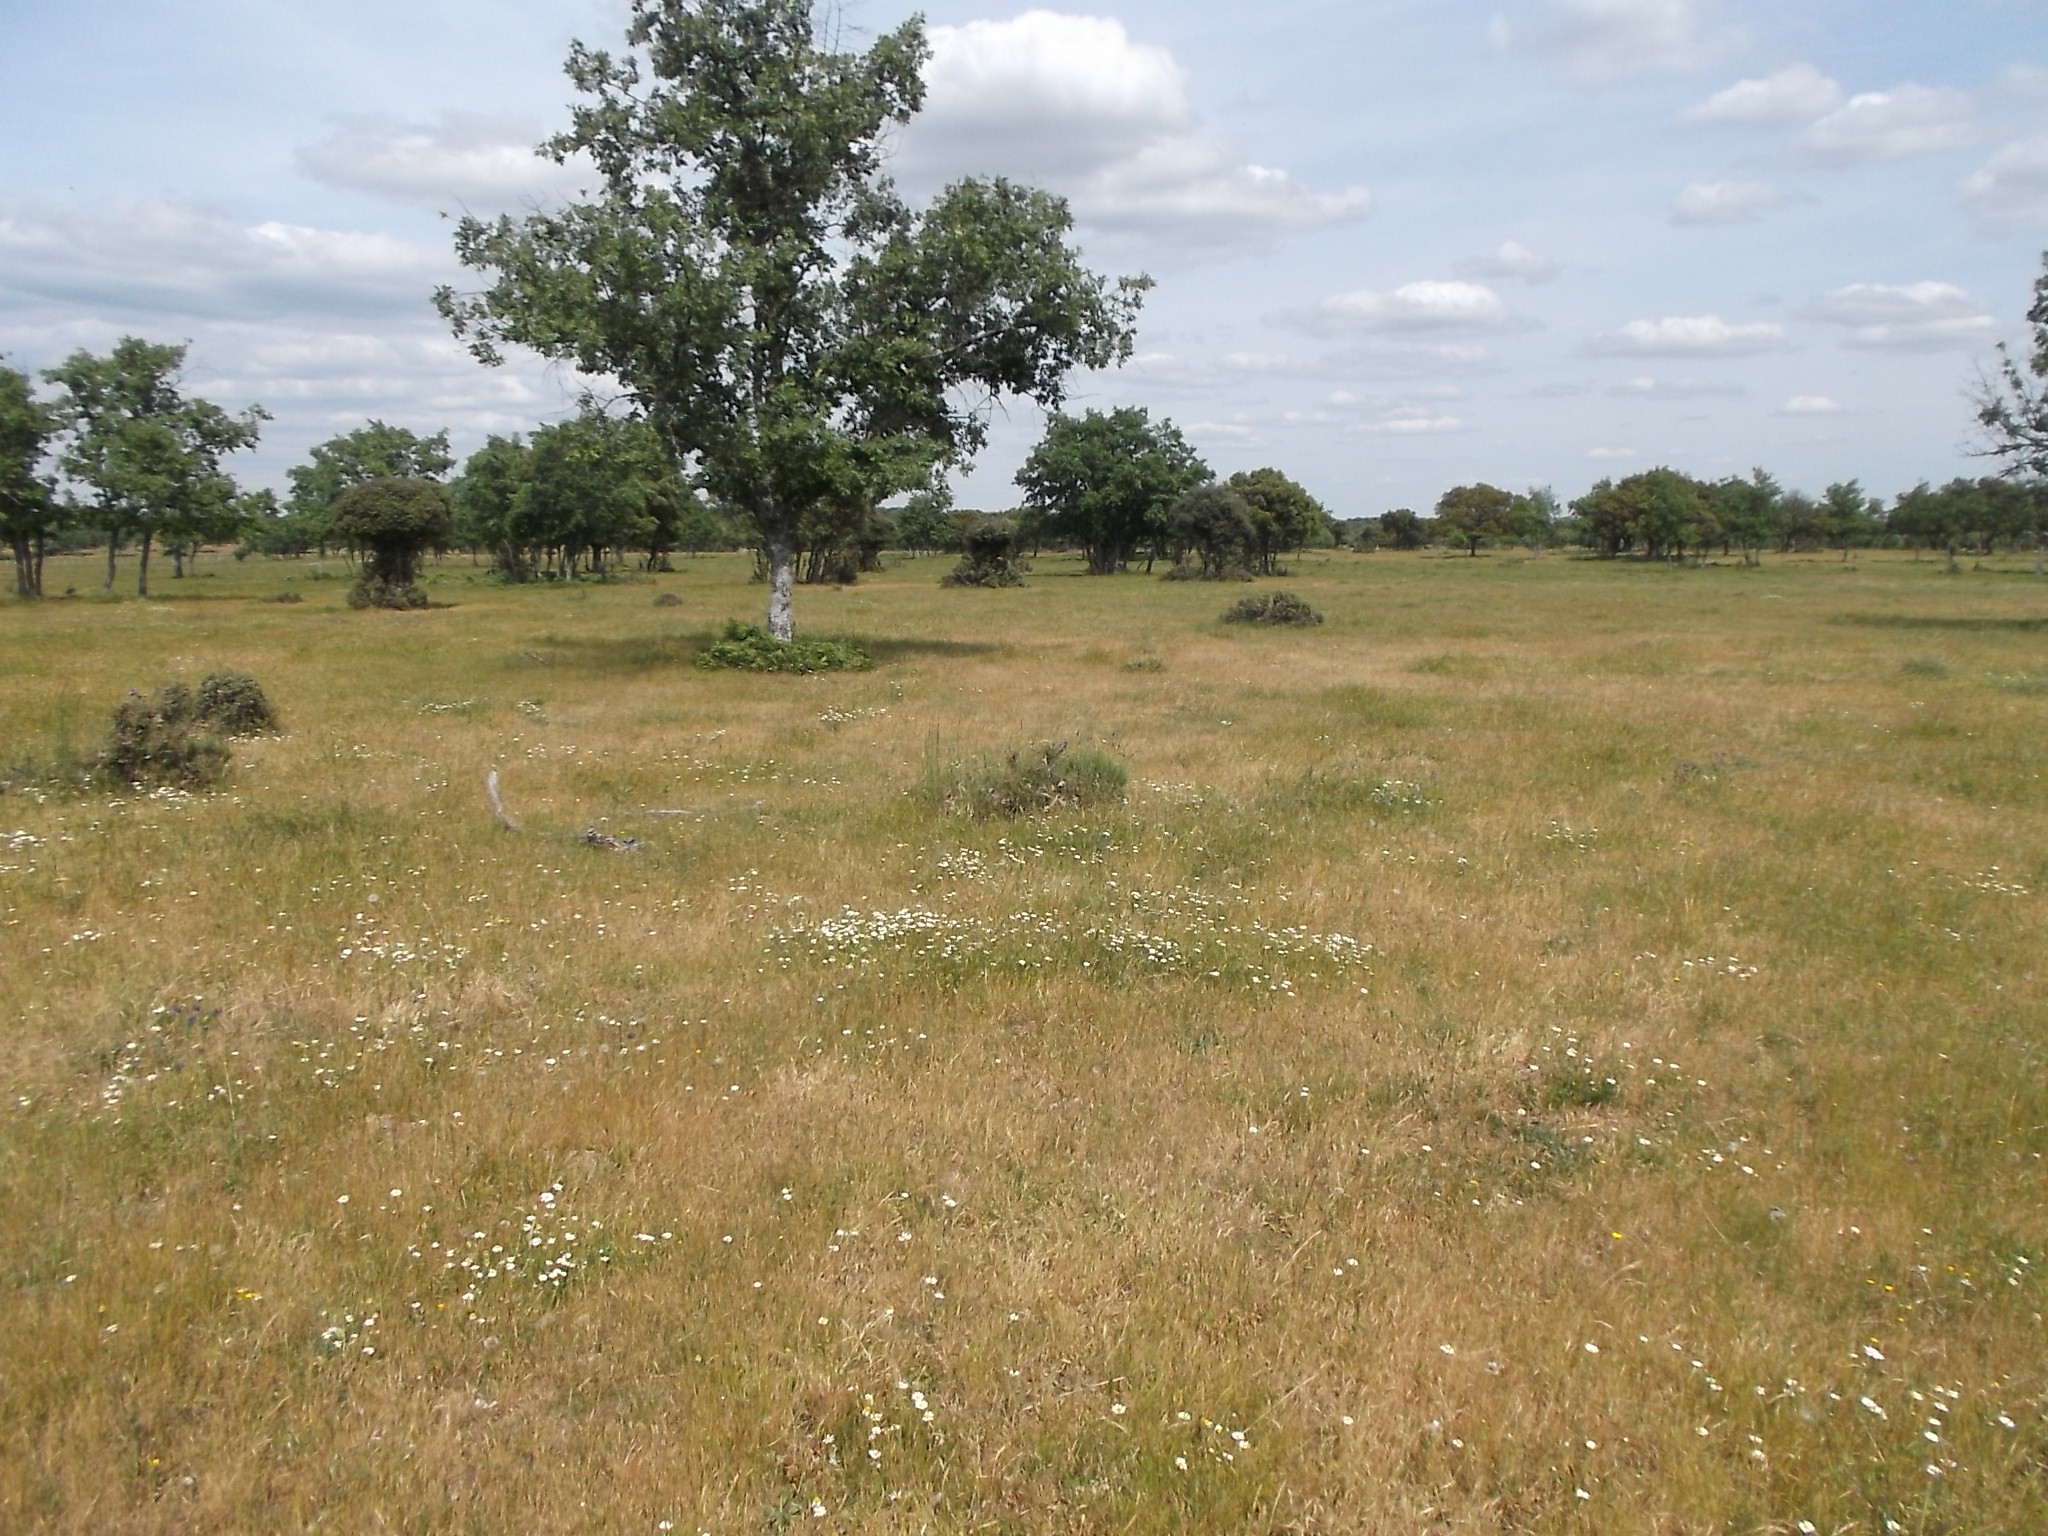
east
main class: Grassland
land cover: Grassland with sparse tree/shrub cover
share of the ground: > 75 %
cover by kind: herbaceous plants 90 %, broadleaved forest trees 5 %, shrubs 5 %
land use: Agriculture (excluding fallow land and kitchen gardens)
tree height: < 5 m
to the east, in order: Grassland with sparse tree/shrub cover; Grassland without tree/shrub cover; Broadleaved woodland; Grassland without tree/shrub cover
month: May
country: ES
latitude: 41.1205
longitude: -6.3025
